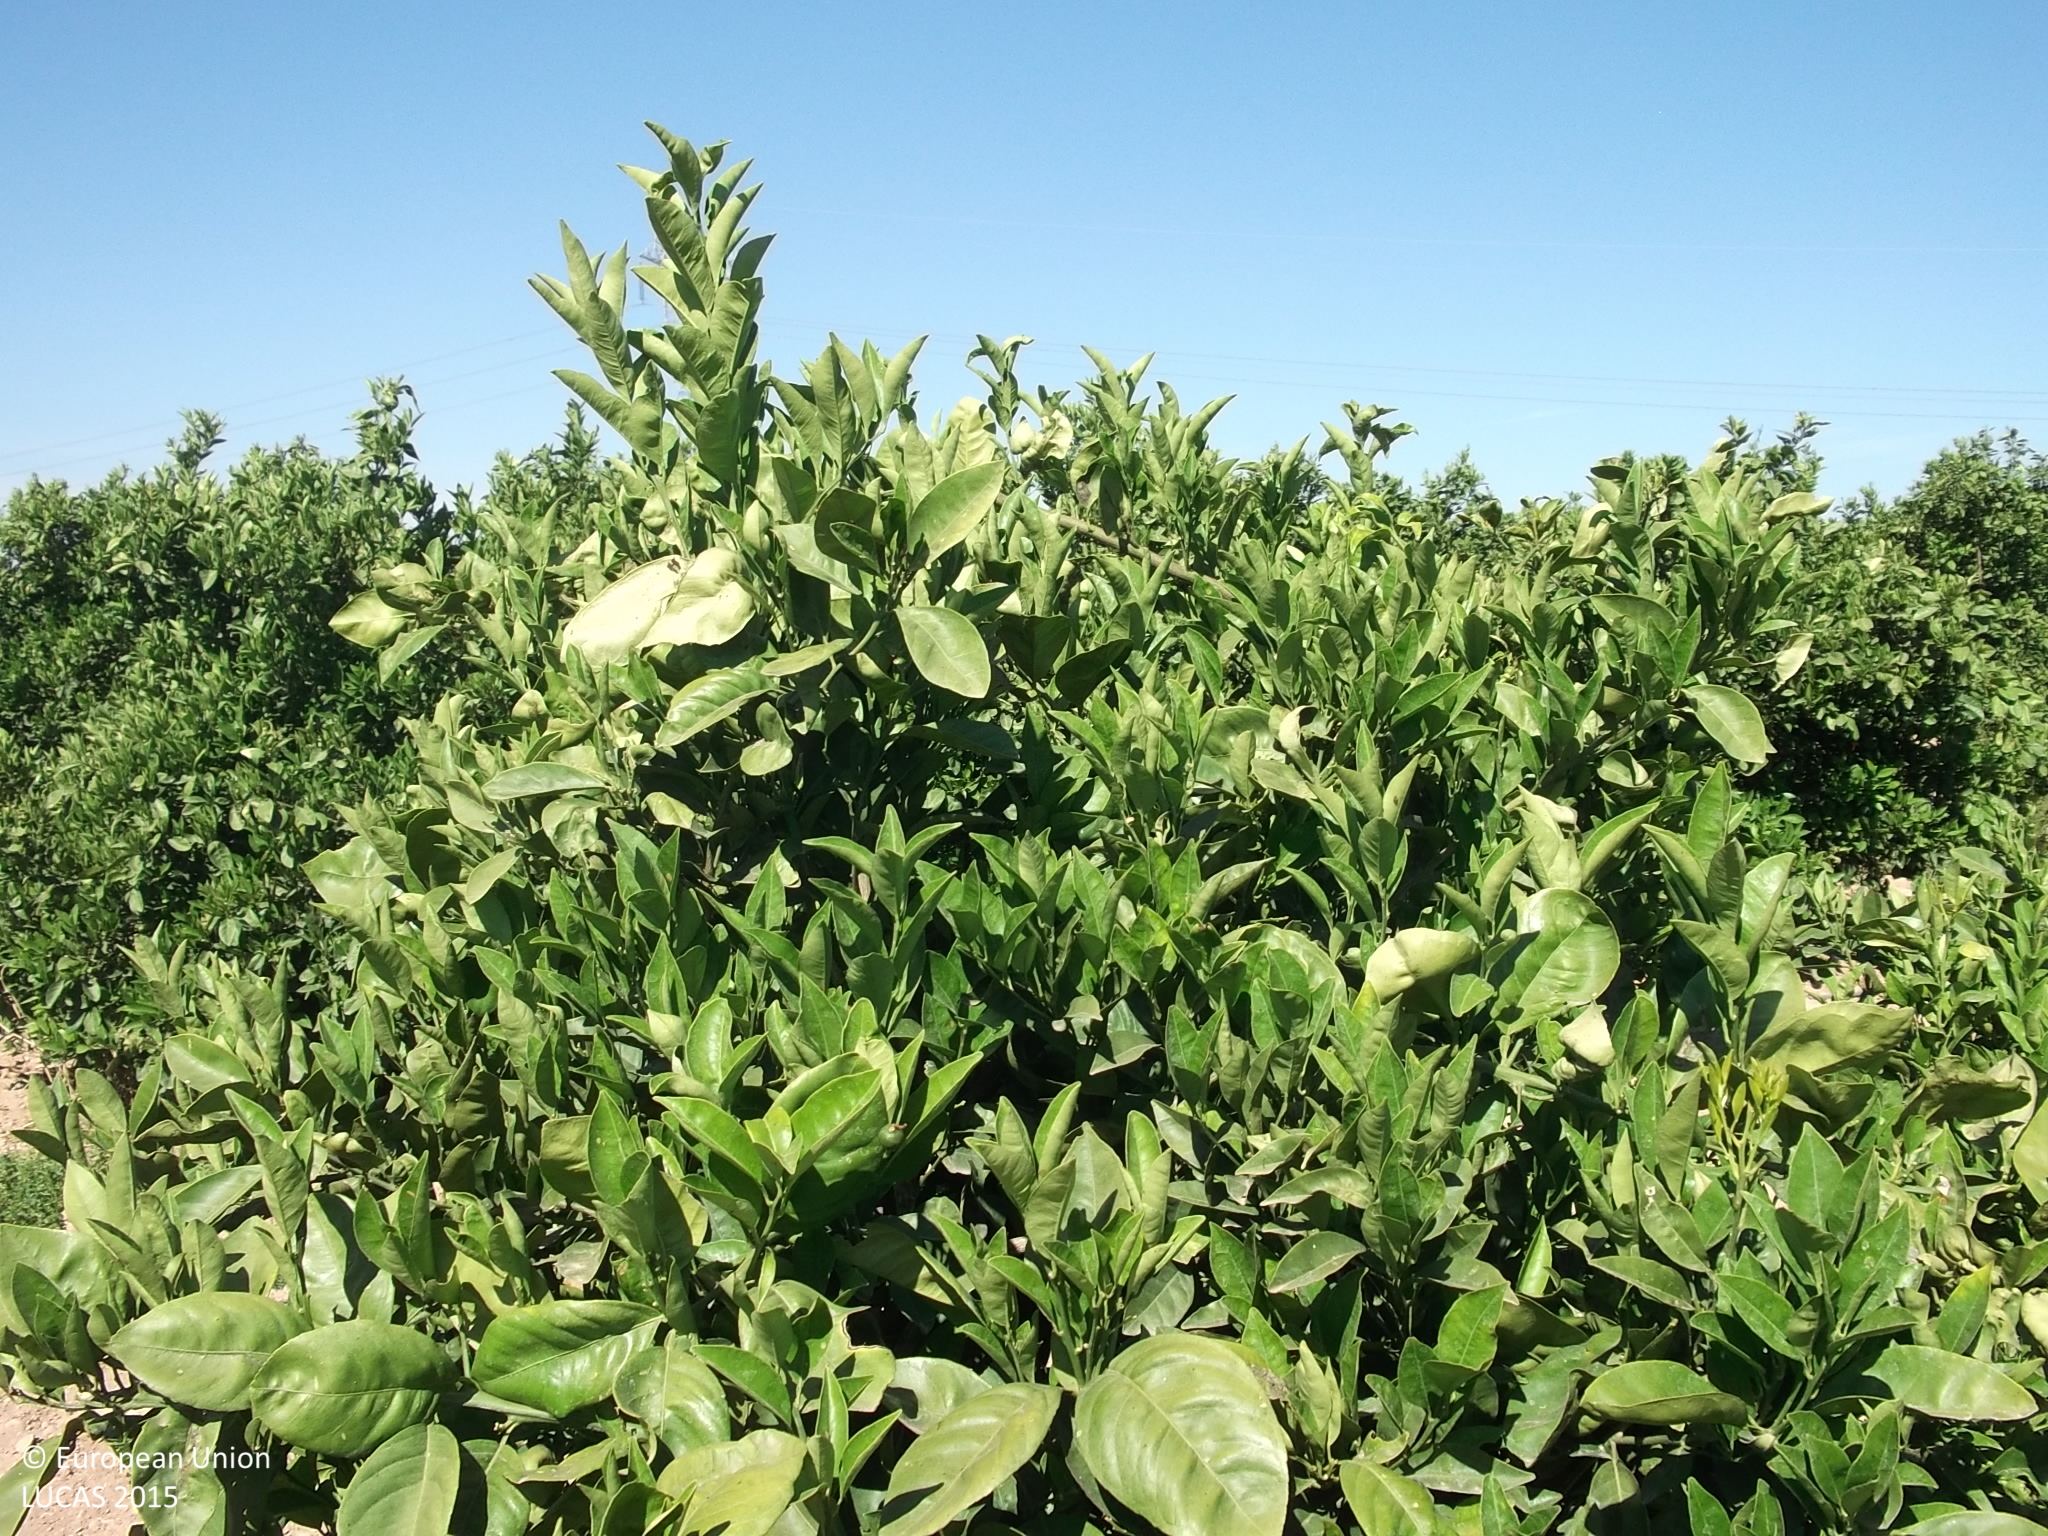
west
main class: Cropland
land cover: Oranges
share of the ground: 10 - 25 %
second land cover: Other bare soil
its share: > 75 %
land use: Agriculture (excluding fallow land and kitchen gardens)
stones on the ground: < 10 %
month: May
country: ES
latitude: 38.1756
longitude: -0.9325
